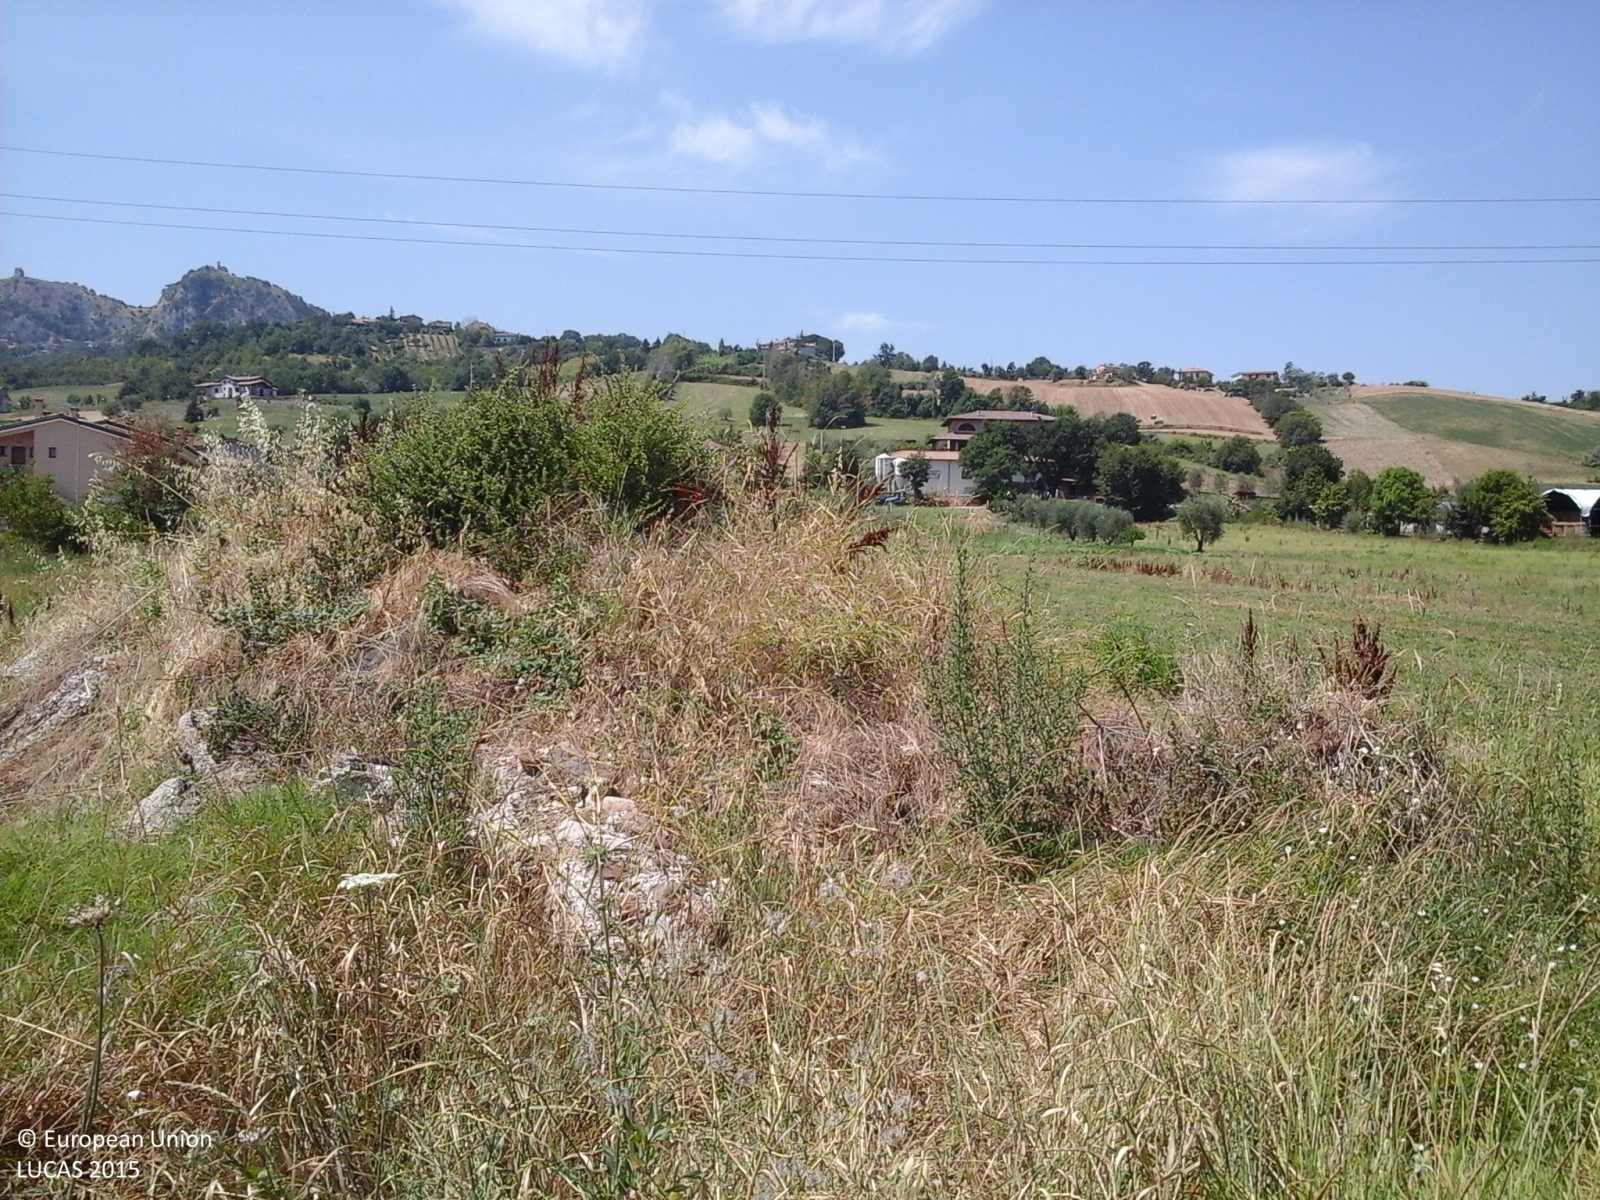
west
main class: Grassland
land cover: Spontaneously vegetated surfaces
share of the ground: > 75 %
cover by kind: herbaceous plants 100 %
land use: Fallow land
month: July
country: IT
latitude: 43.9980
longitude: 12.4012
